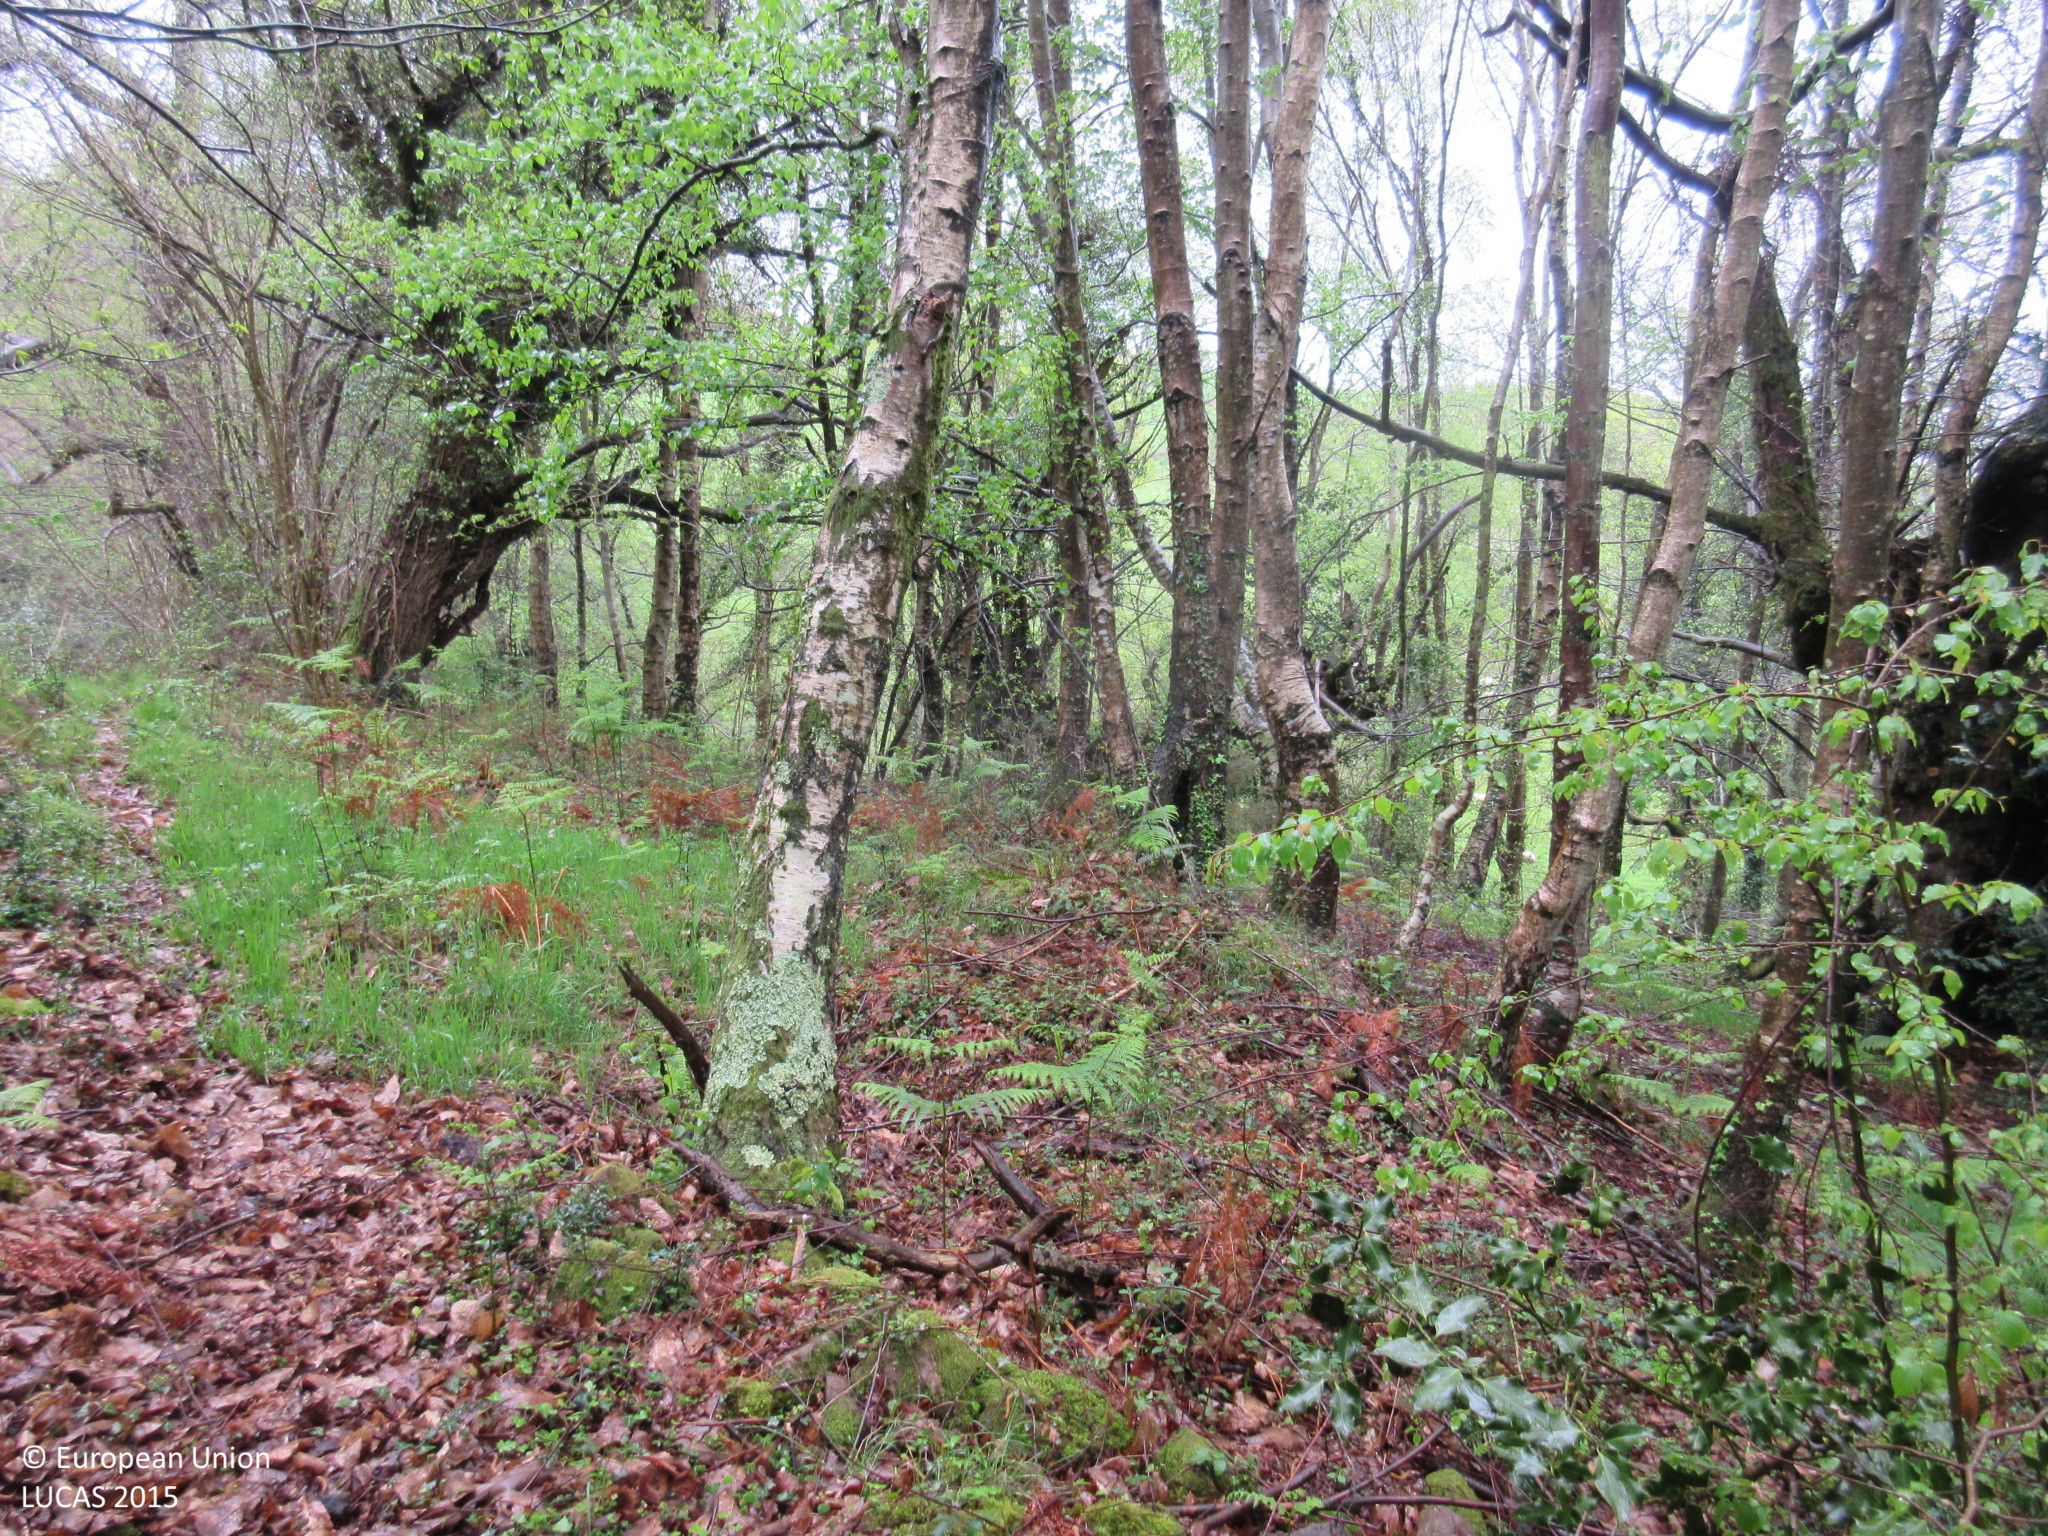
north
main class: Woodland
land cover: Broadleaved woodland
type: acidophilous oak and oak-birch forest
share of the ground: > 75 %
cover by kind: broadleaved forest trees 100 %
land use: Forestry
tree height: > 5 m
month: April
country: ES
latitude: 43.4481
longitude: -5.2879
